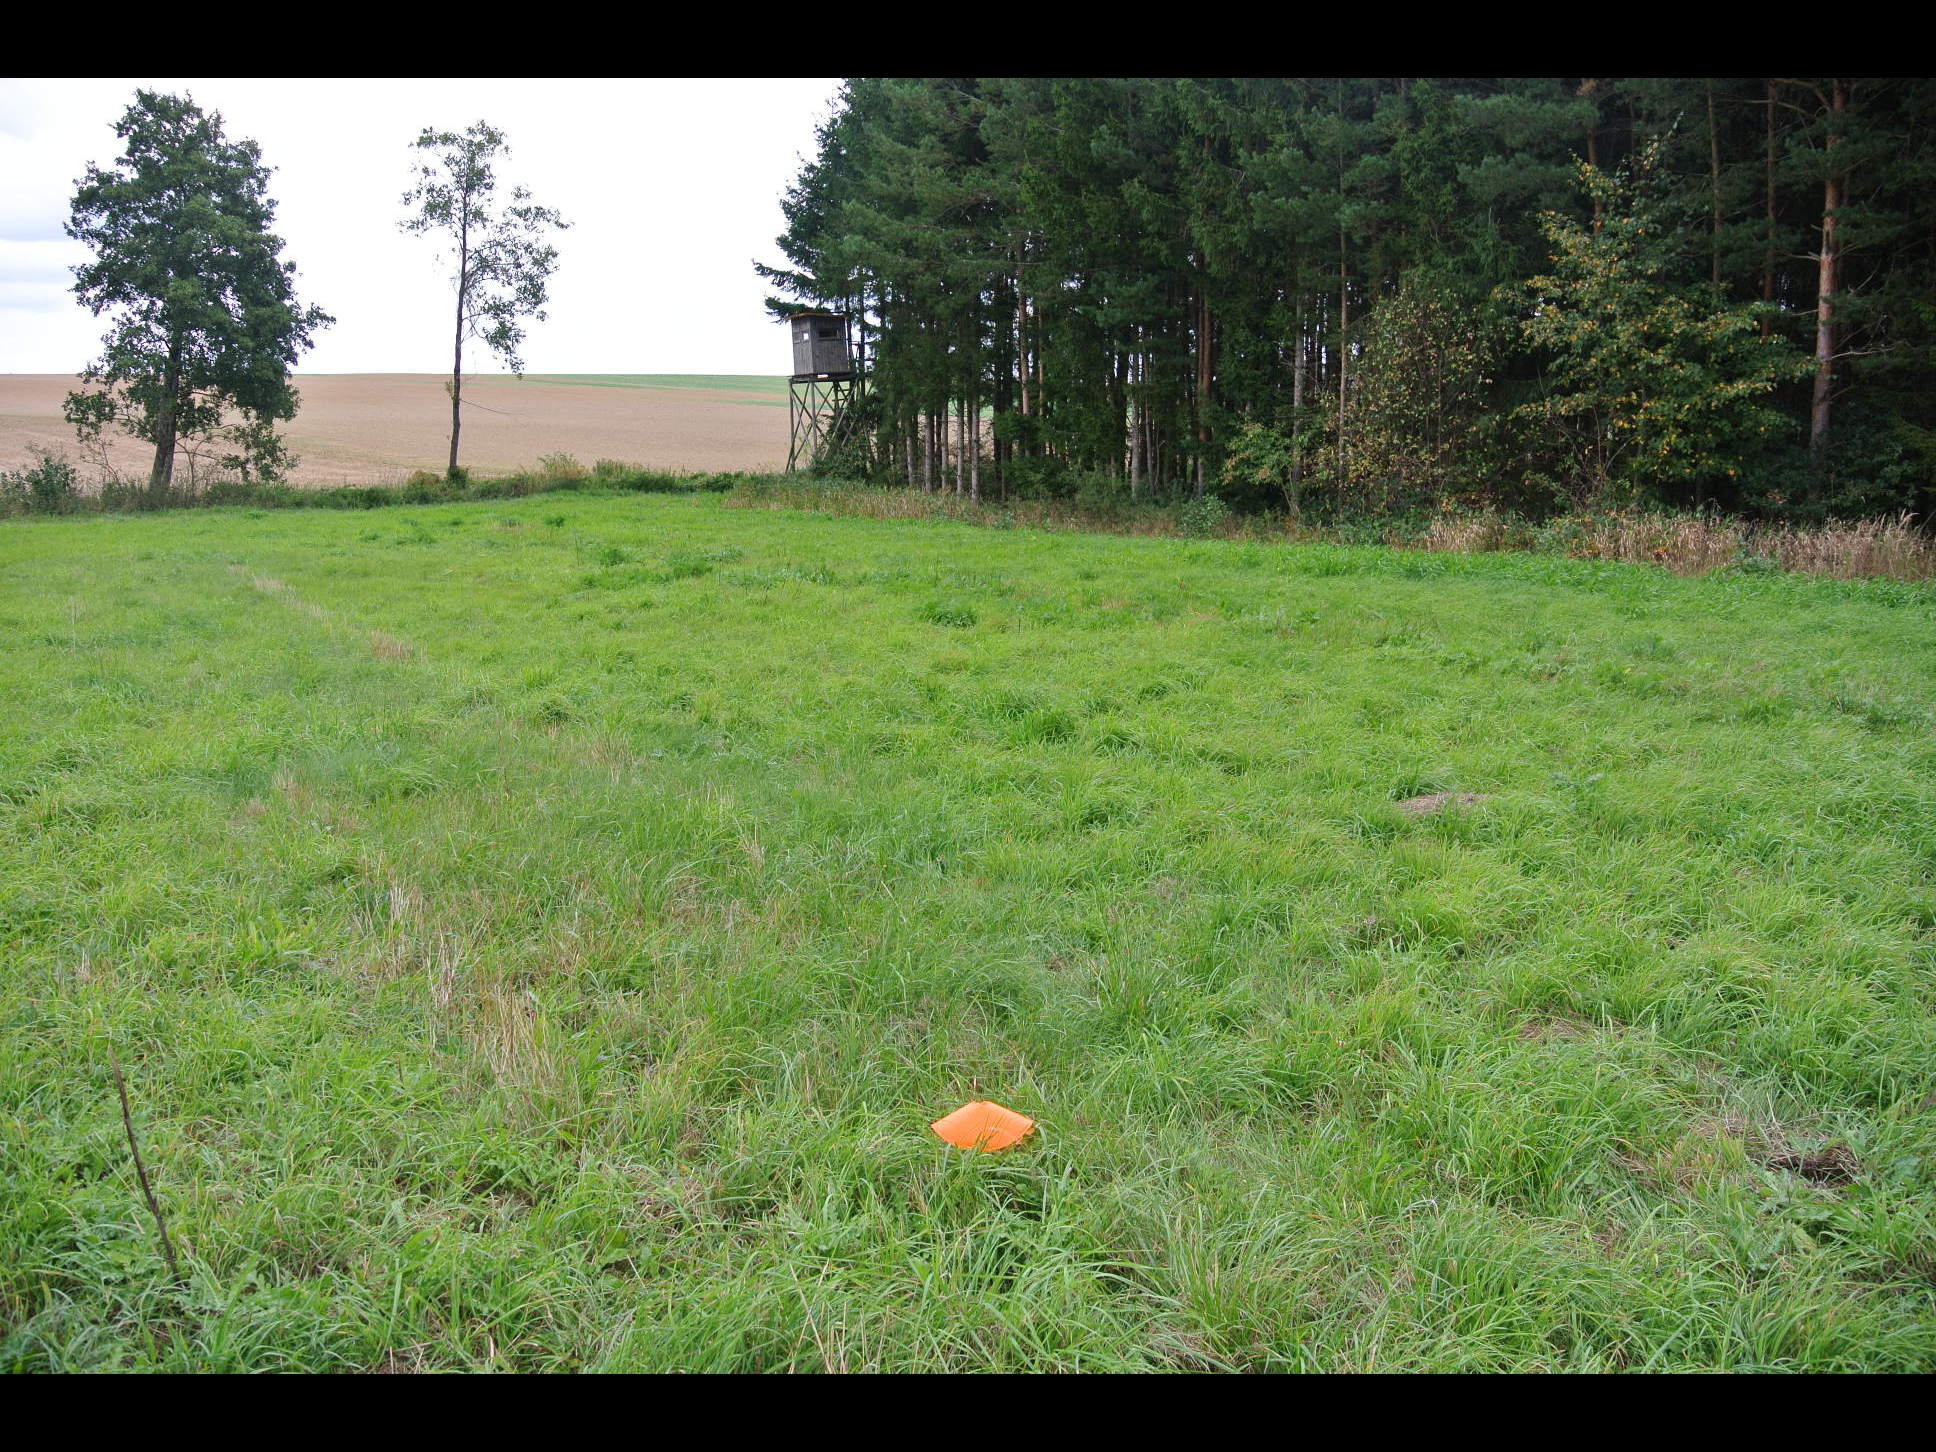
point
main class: Grassland
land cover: Grassland without tree/shrub cover
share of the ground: > 75 %
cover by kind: herbaceous plants 100 %
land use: Agriculture (excluding fallow land and kitchen gardens)
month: July
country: AT
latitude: 47.4951
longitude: 16.4148
